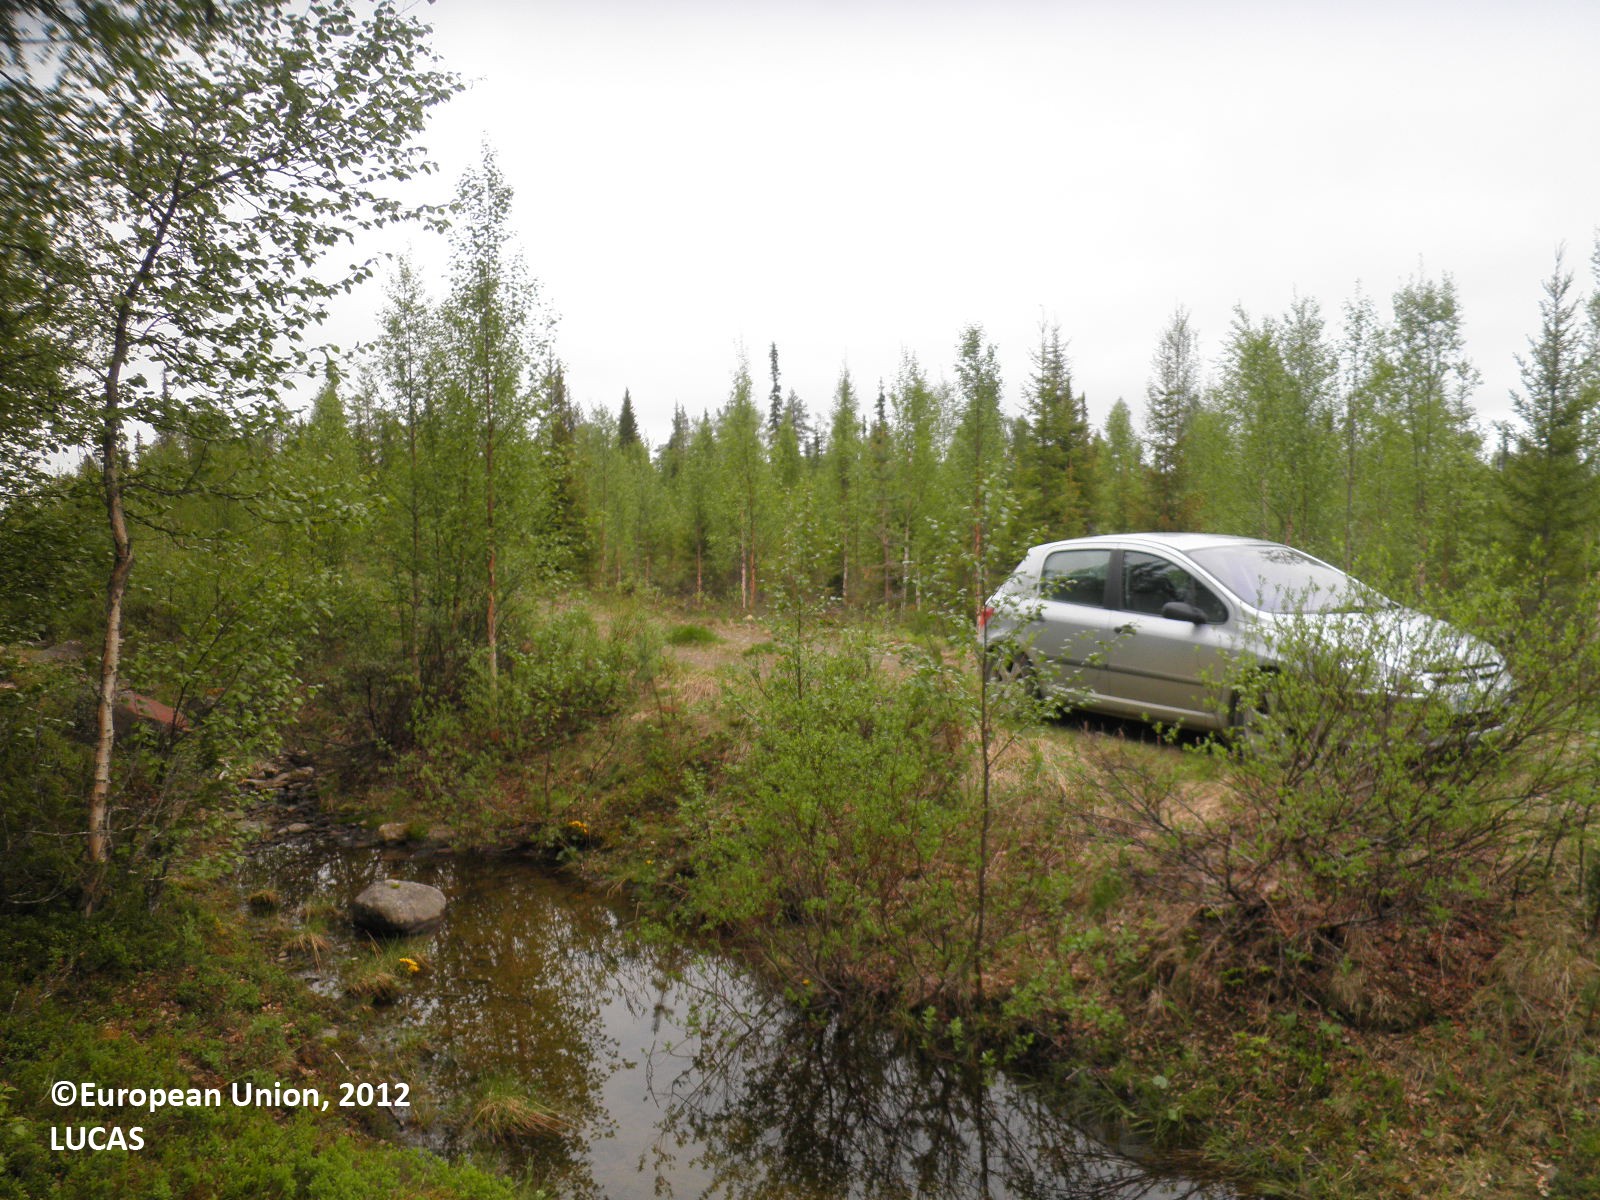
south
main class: Woodland
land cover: Spruce dominated mixed woodland
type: boreal forest
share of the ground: 25 - 50 %
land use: Forestry
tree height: > 5 m
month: June
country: FI
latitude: 67.8191
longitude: 25.6897
